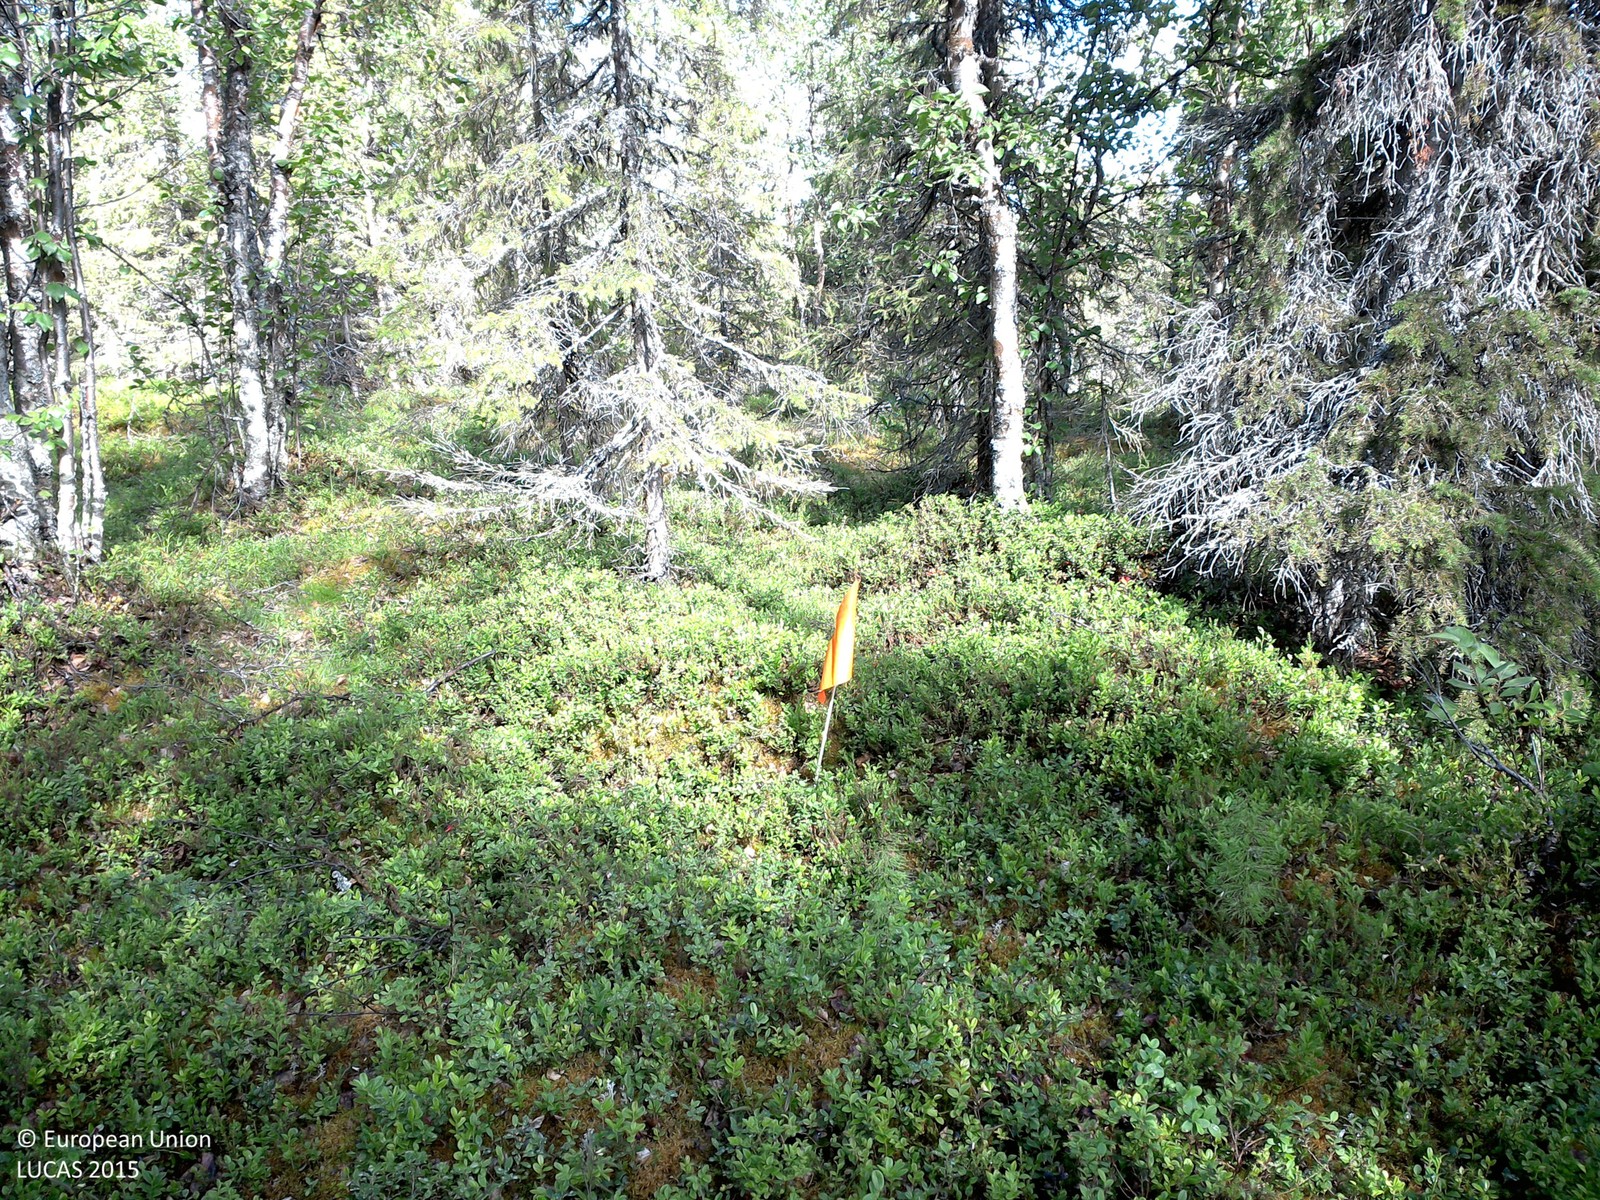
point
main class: Woodland
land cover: Spruce dominated mixed woodland
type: boreal forest
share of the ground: 25 - 50 %
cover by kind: shrubs 50 %, coniferous forest trees 25 %, broadleaved forest trees 15 %, lichens and mosses 10 %
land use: Forestry
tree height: > 5 m
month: July
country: SE
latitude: 67.6216
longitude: 21.2678
